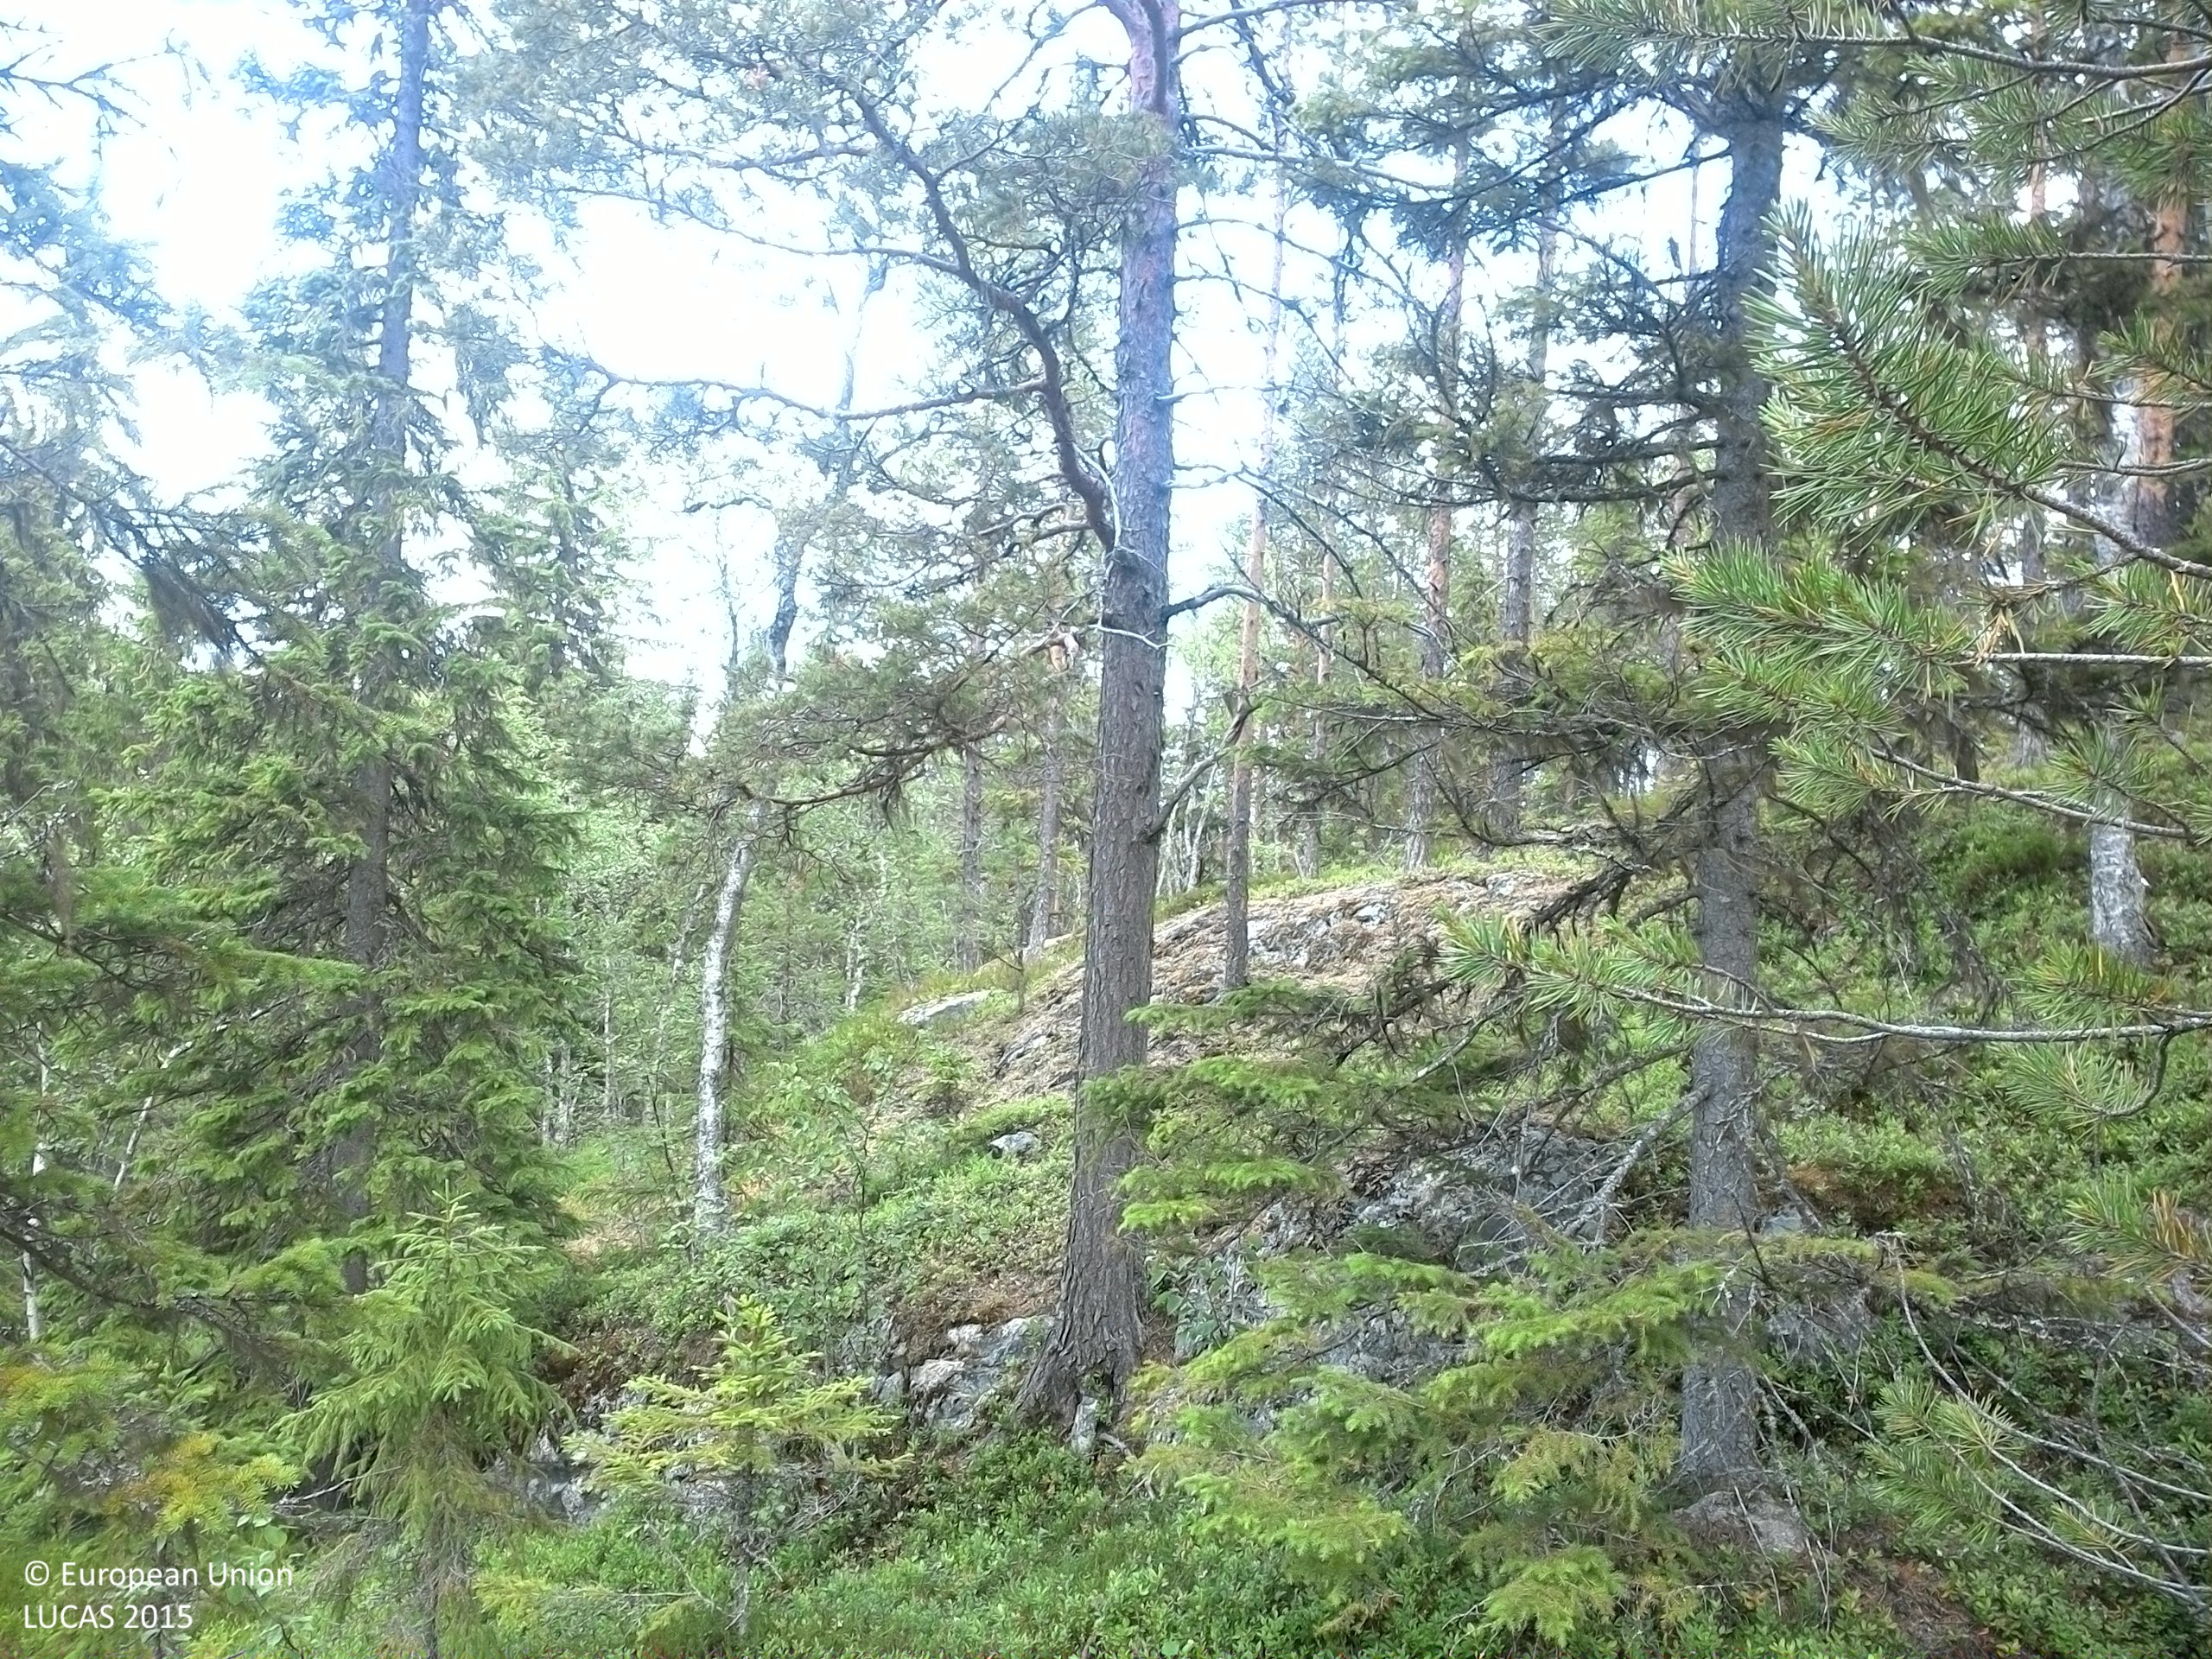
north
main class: Woodland
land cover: Pine dominated mixed woodland
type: boreal forest
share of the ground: 50 - 75 %
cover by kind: coniferous forest trees 45 %, shrubs 20 %, broadleaved forest trees 15 %, lichens and mosses 10 %, consolidated bare surface 10 %
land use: Forestry
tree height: > 5 m
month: July
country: SE
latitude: 63.5665
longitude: 17.8870
